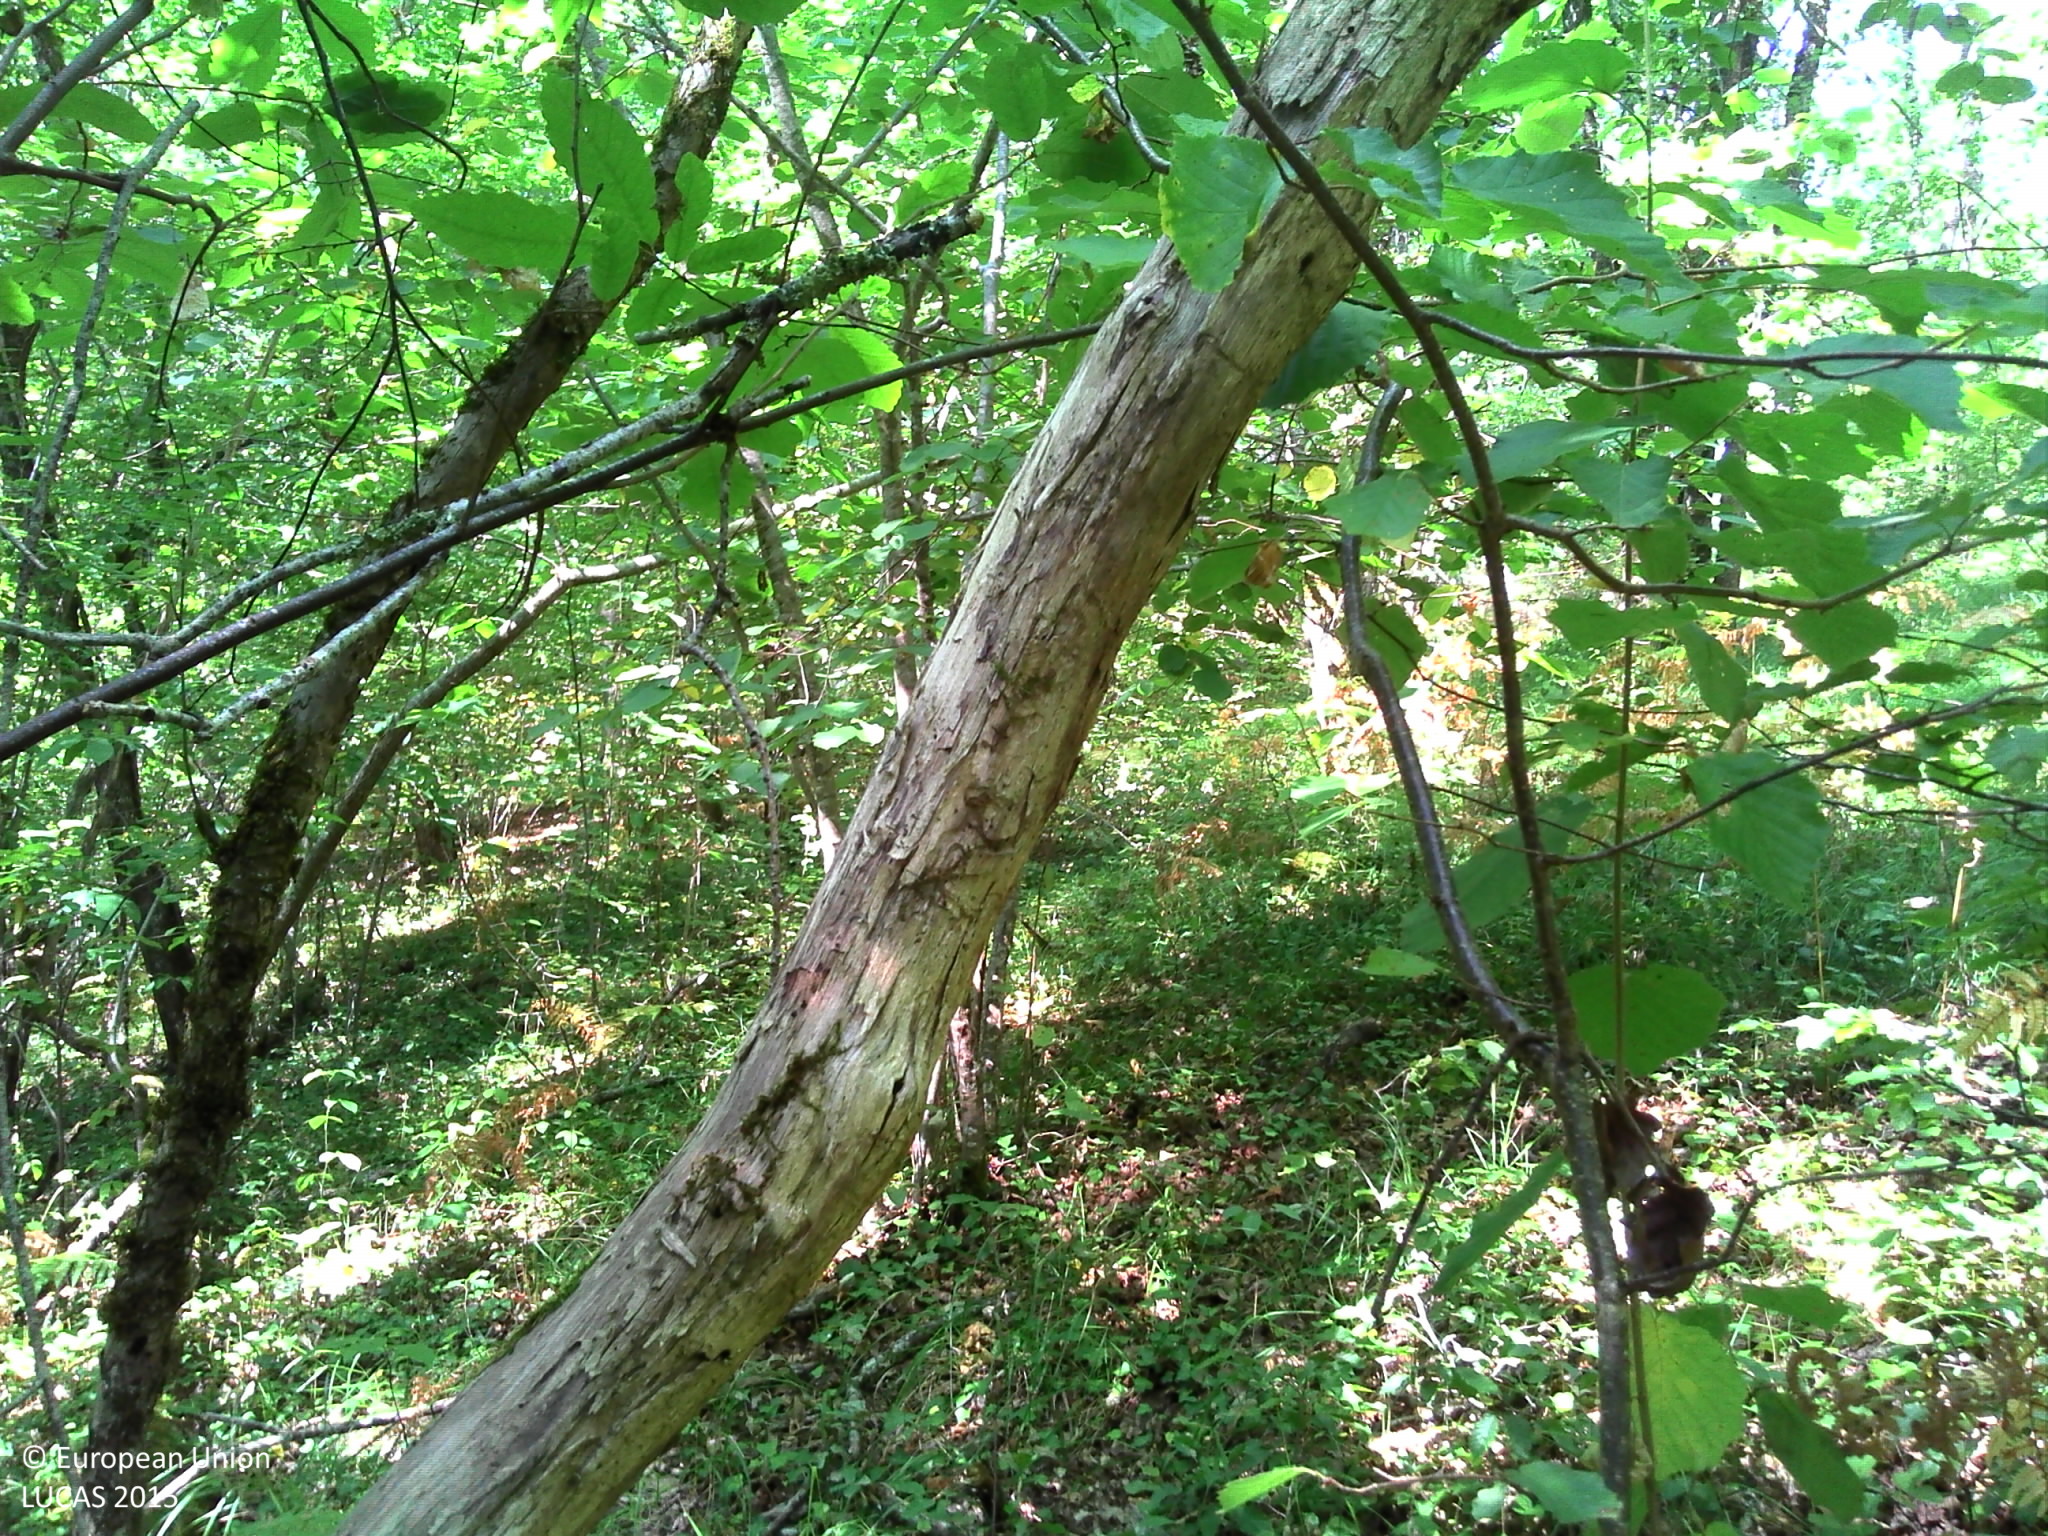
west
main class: Woodland
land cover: Broadleaved woodland
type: mesophytic deciduous forest
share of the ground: > 75 %
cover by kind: broadleaved forest trees 80 %, herbaceous plants 10 %, shrubs 5 %, lichens and mosses 5 %
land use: Forestry
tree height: > 5 m
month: August
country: FR
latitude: 44.7560
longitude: 0.7837
